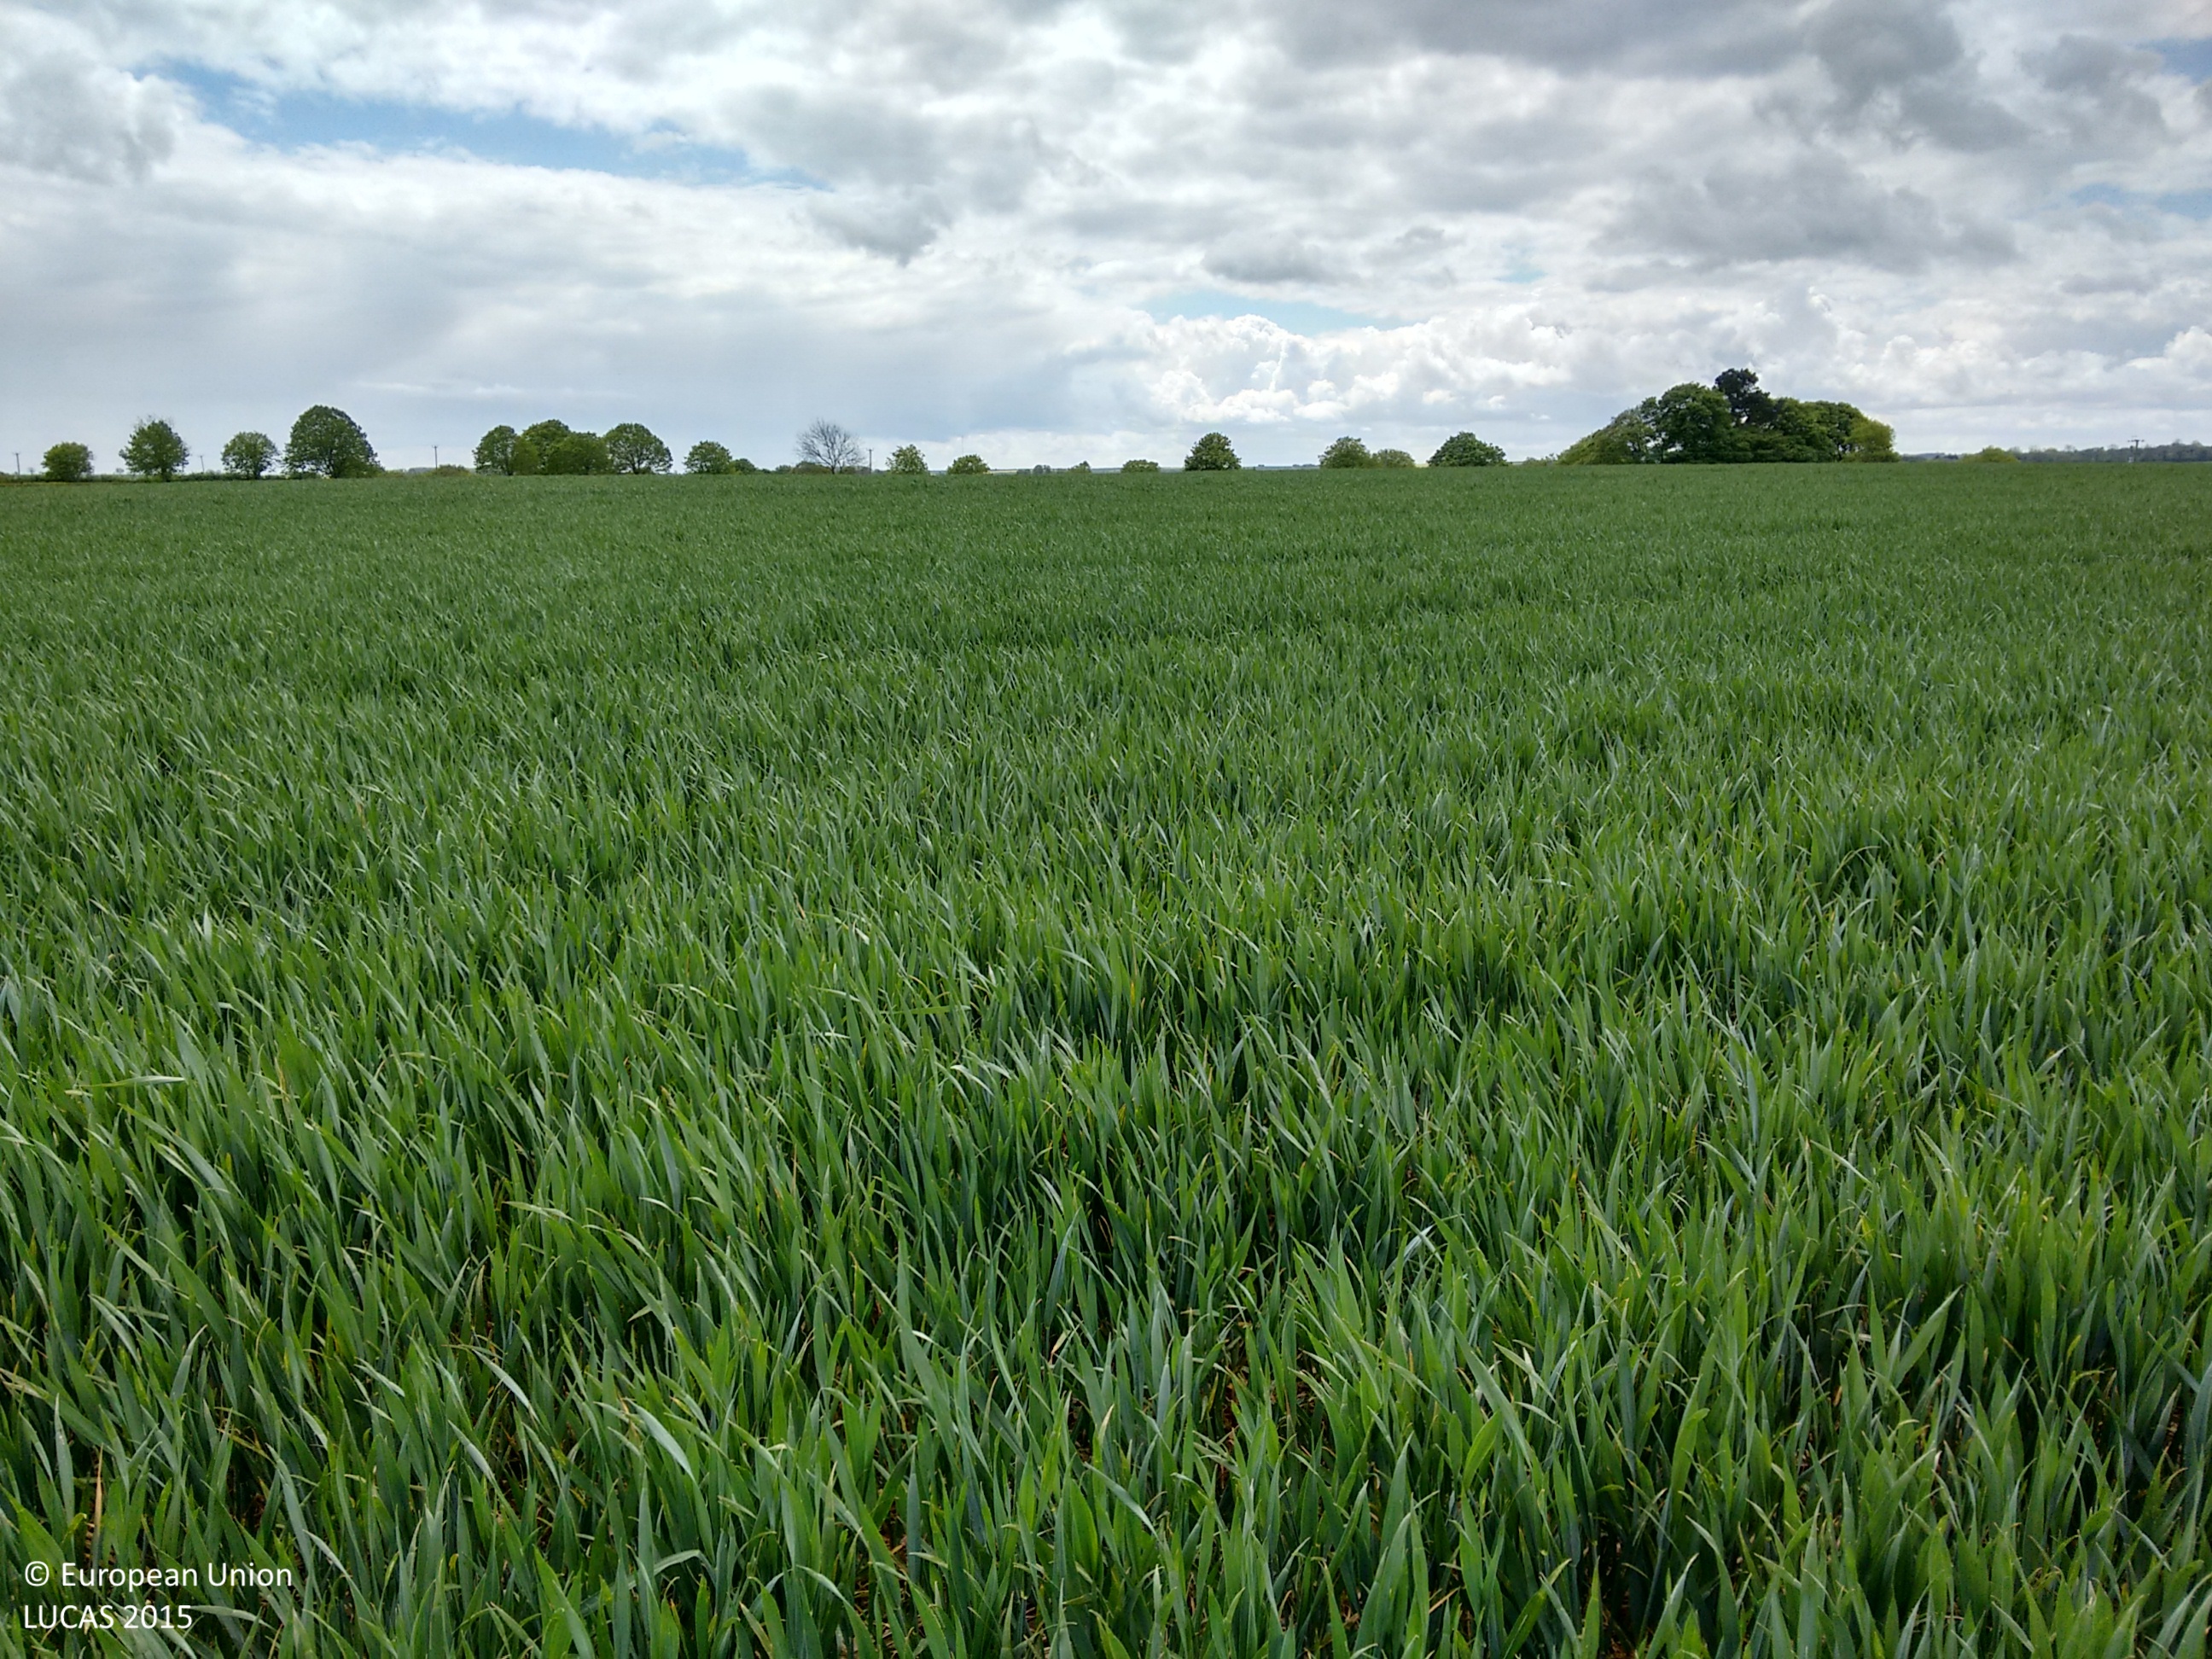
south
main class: Cropland
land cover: Common wheat
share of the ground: > 75 %
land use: Agriculture (excluding fallow land and kitchen gardens)
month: May
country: GB
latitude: 53.4620
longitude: -0.1703
